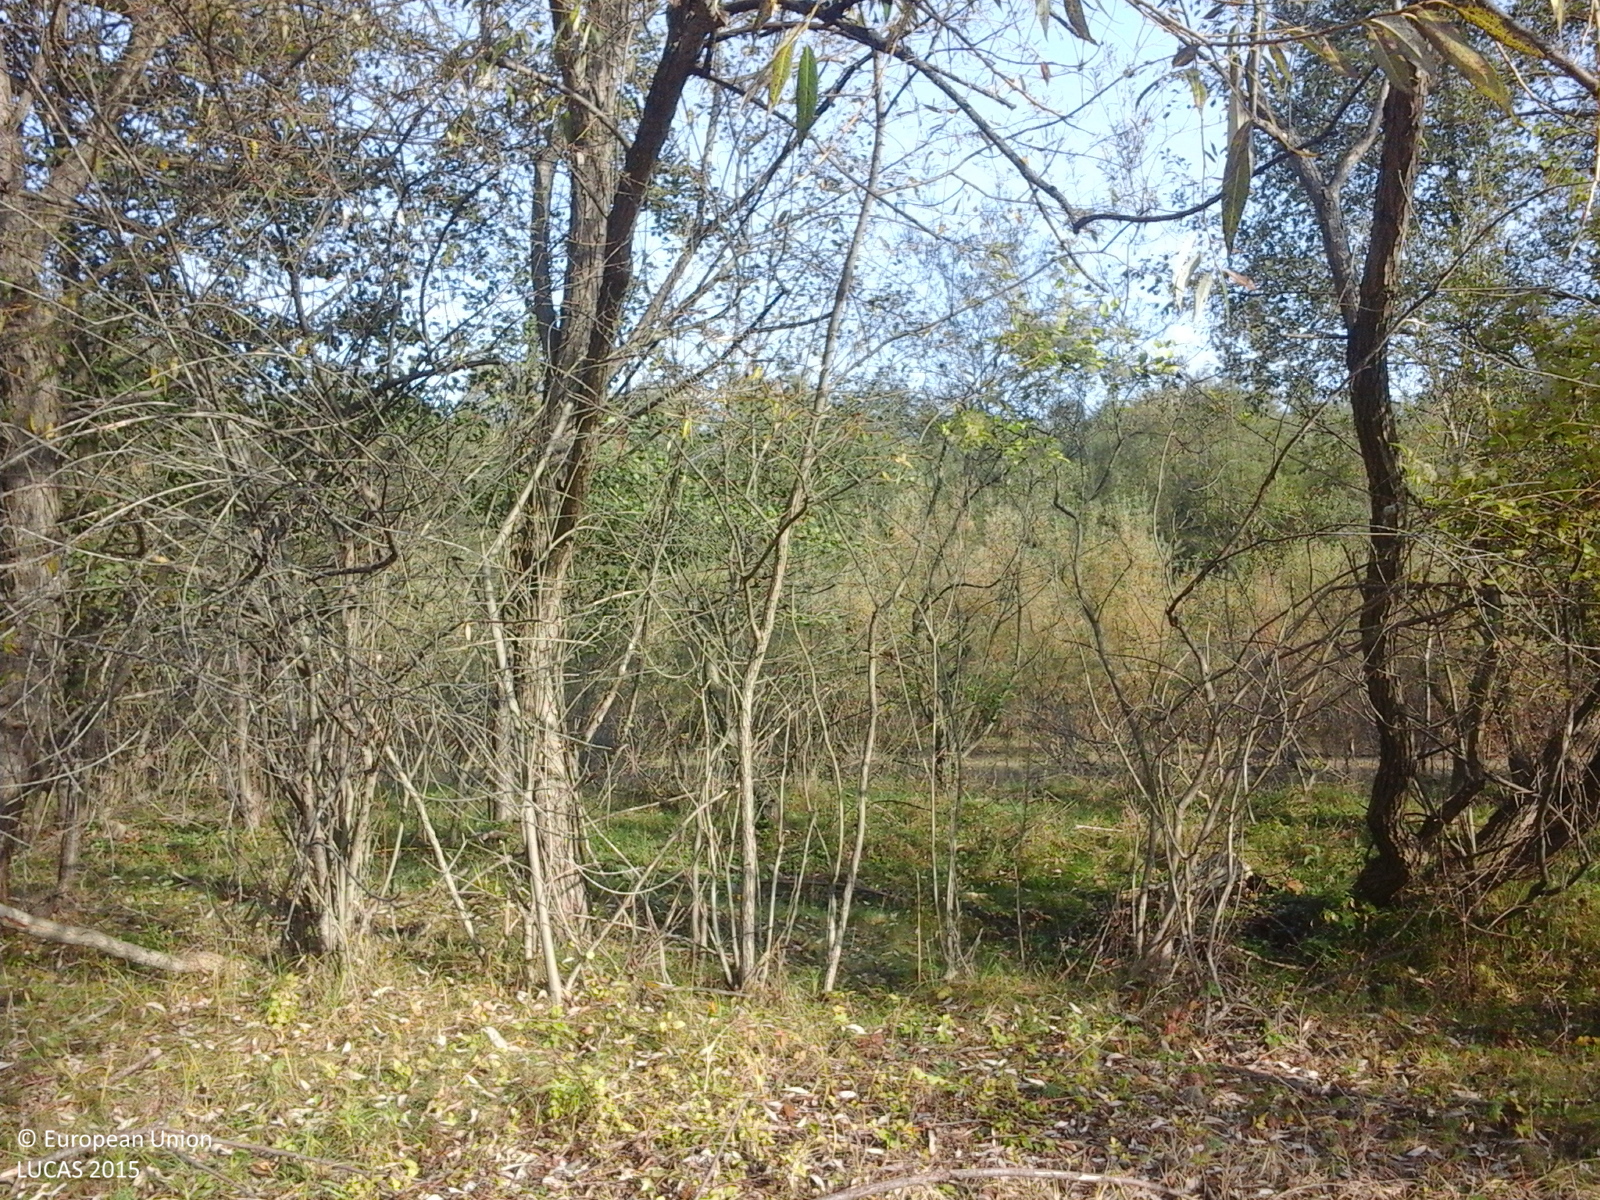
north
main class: Woodland
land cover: Broadleaved woodland
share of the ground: > 75 %
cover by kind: broadleaved forest trees 100 %
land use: Semi-natural and natural areas not in use
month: October
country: RO
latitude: 45.9811
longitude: 26.9351
